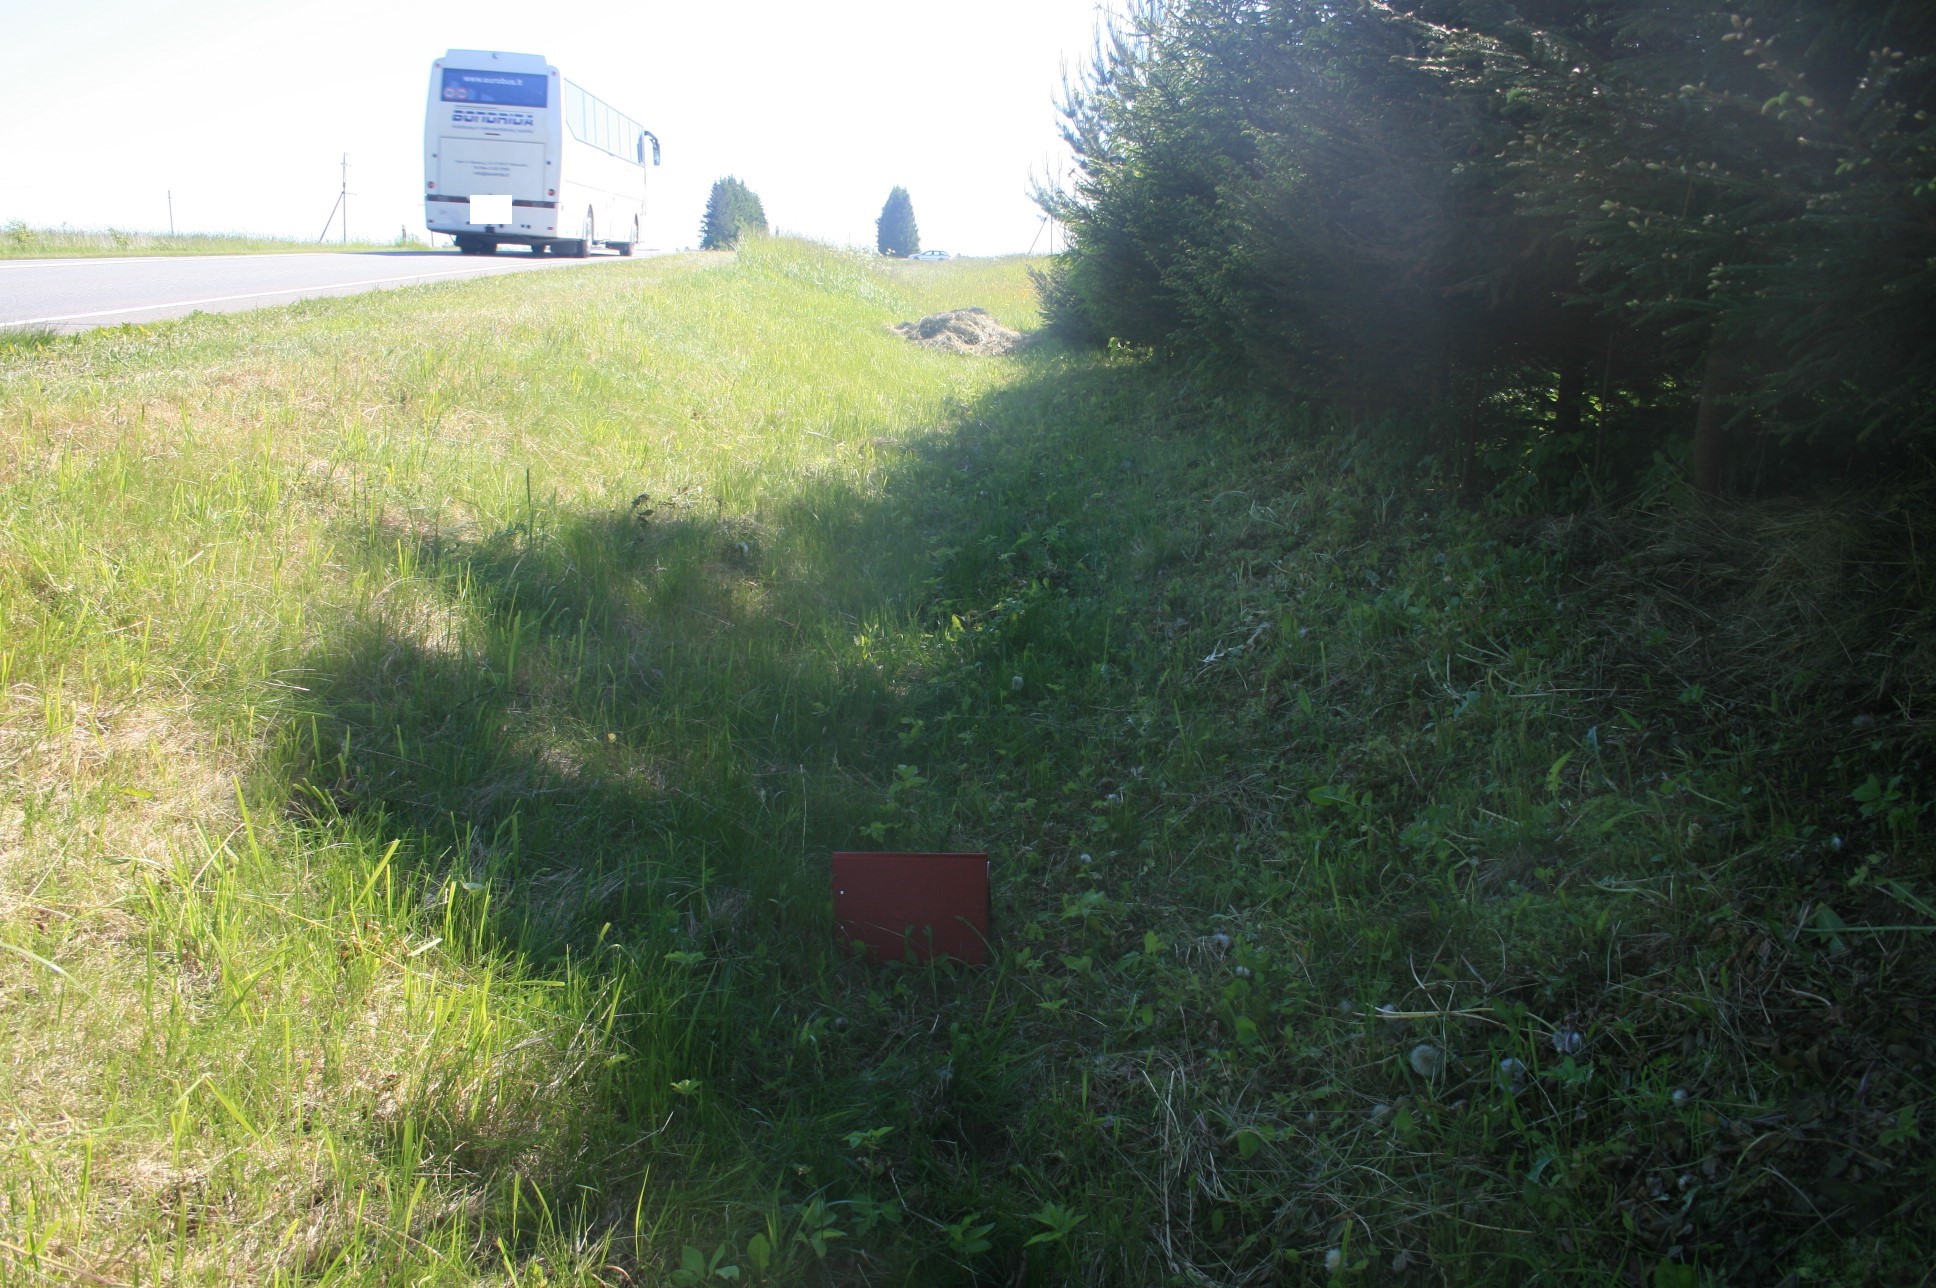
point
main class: Grassland
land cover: Grassland without tree/shrub cover
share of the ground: > 75 %
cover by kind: herbaceous plants 100 %
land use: Road transport
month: June
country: LT
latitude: 55.9217
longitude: 21.5183
